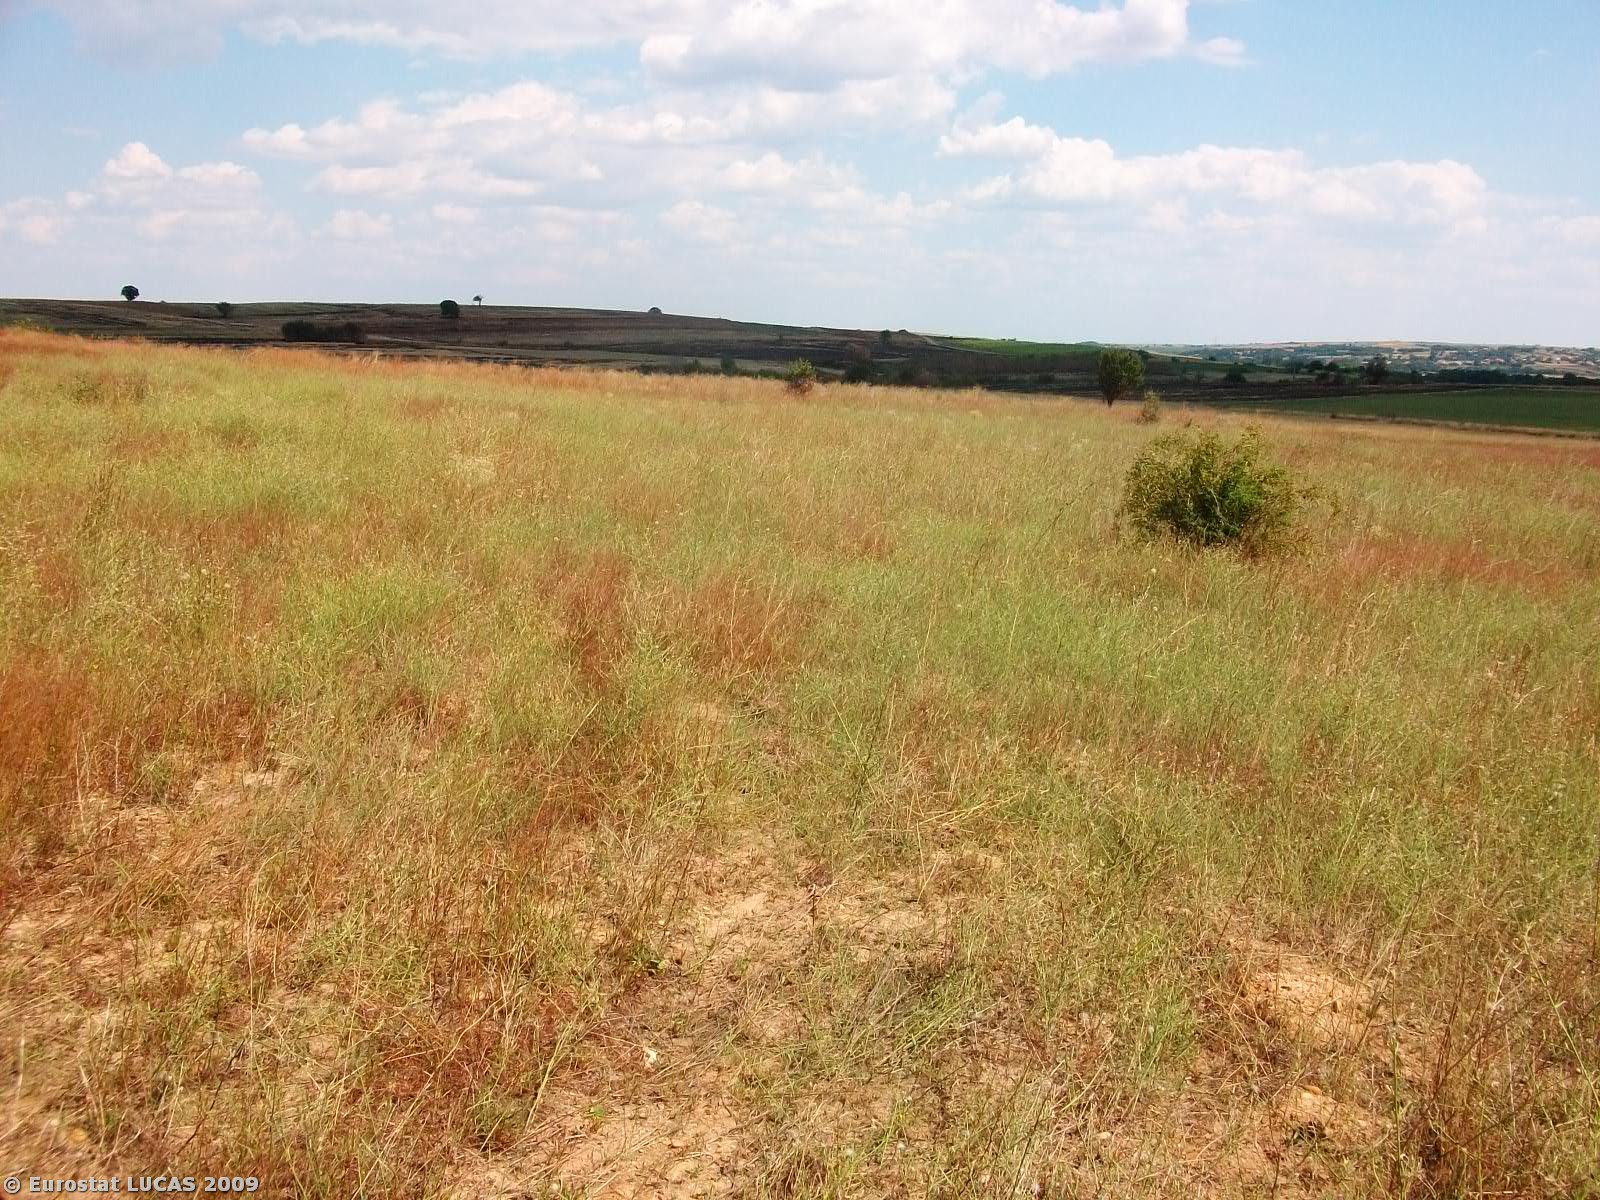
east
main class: Grassland
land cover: Grassland without tree/shrub cover
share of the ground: 50 - 75 %
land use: Unused
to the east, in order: Grassland without tree/shrub cover; Grass margins; Spontaneously vegetated surfaces; Common wheat
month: August
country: GR
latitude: 41.5078
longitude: 26.4067
